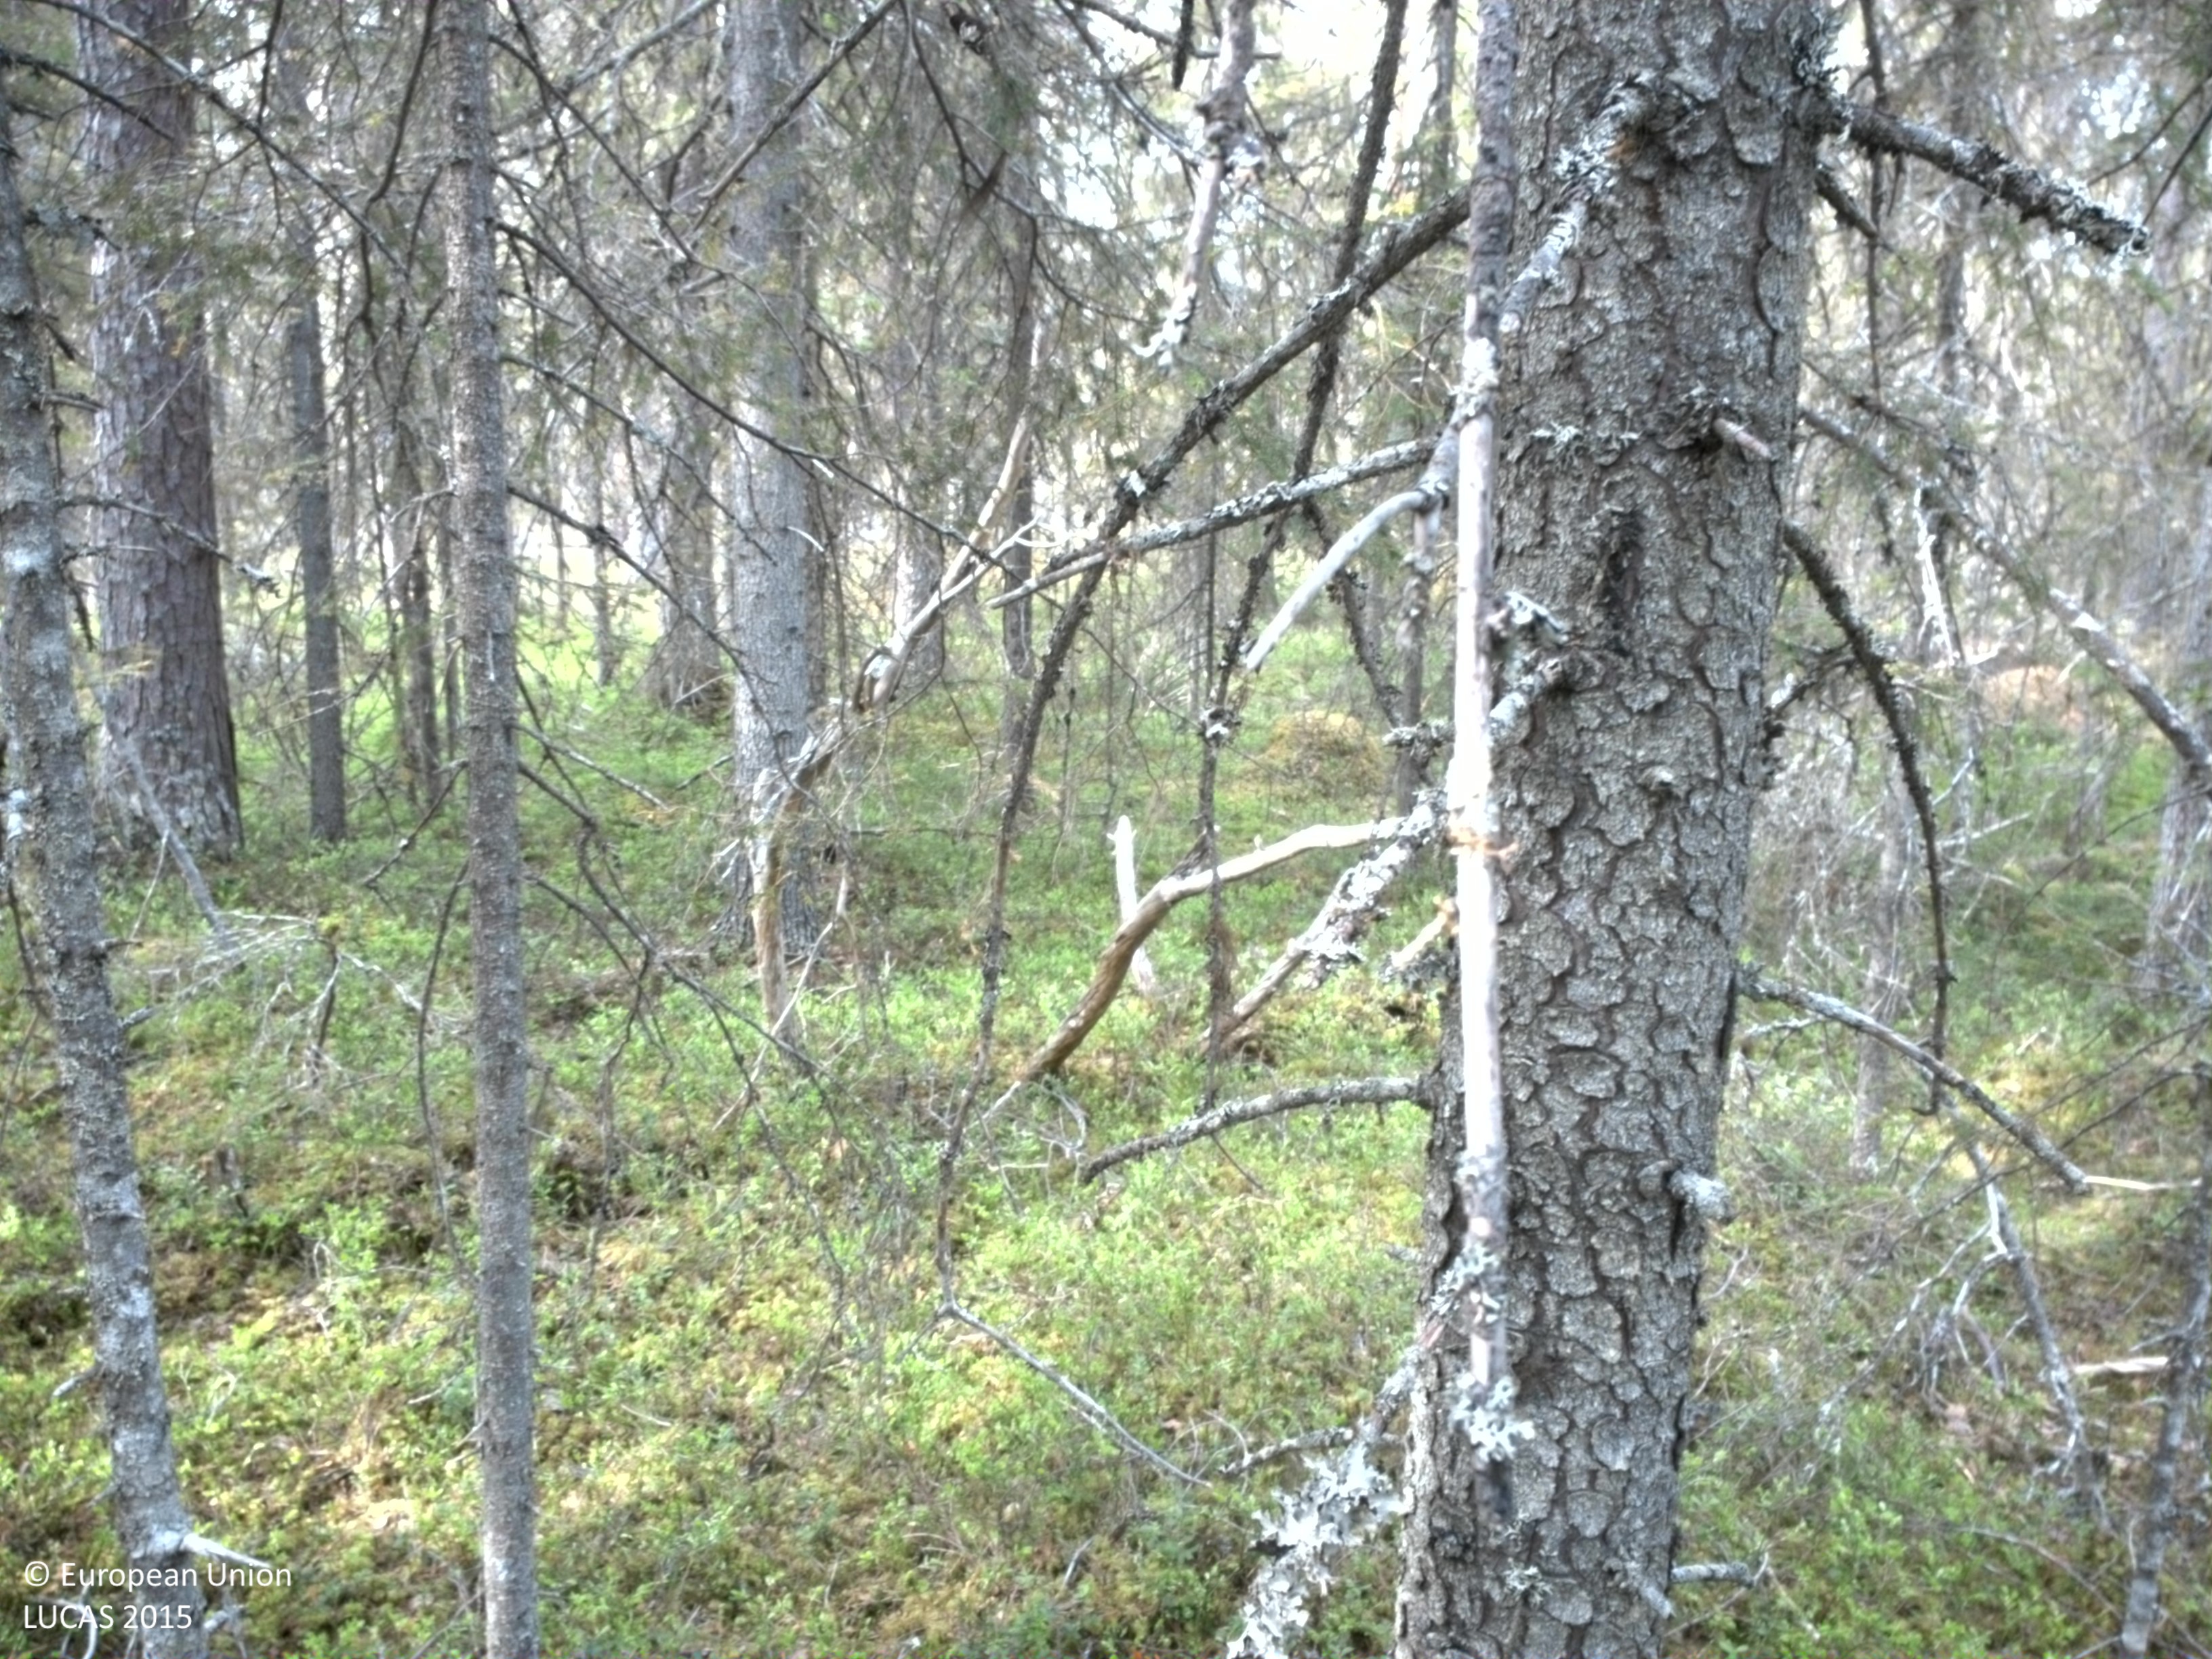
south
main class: Woodland
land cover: Other coniferous woodland
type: boreal forest
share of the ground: 50 - 75 %
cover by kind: coniferous forest trees 65 %, shrubs 35 %
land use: Amenities, museums, leisure
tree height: > 5 m
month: June
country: SE
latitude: 65.7588
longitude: 19.7175
